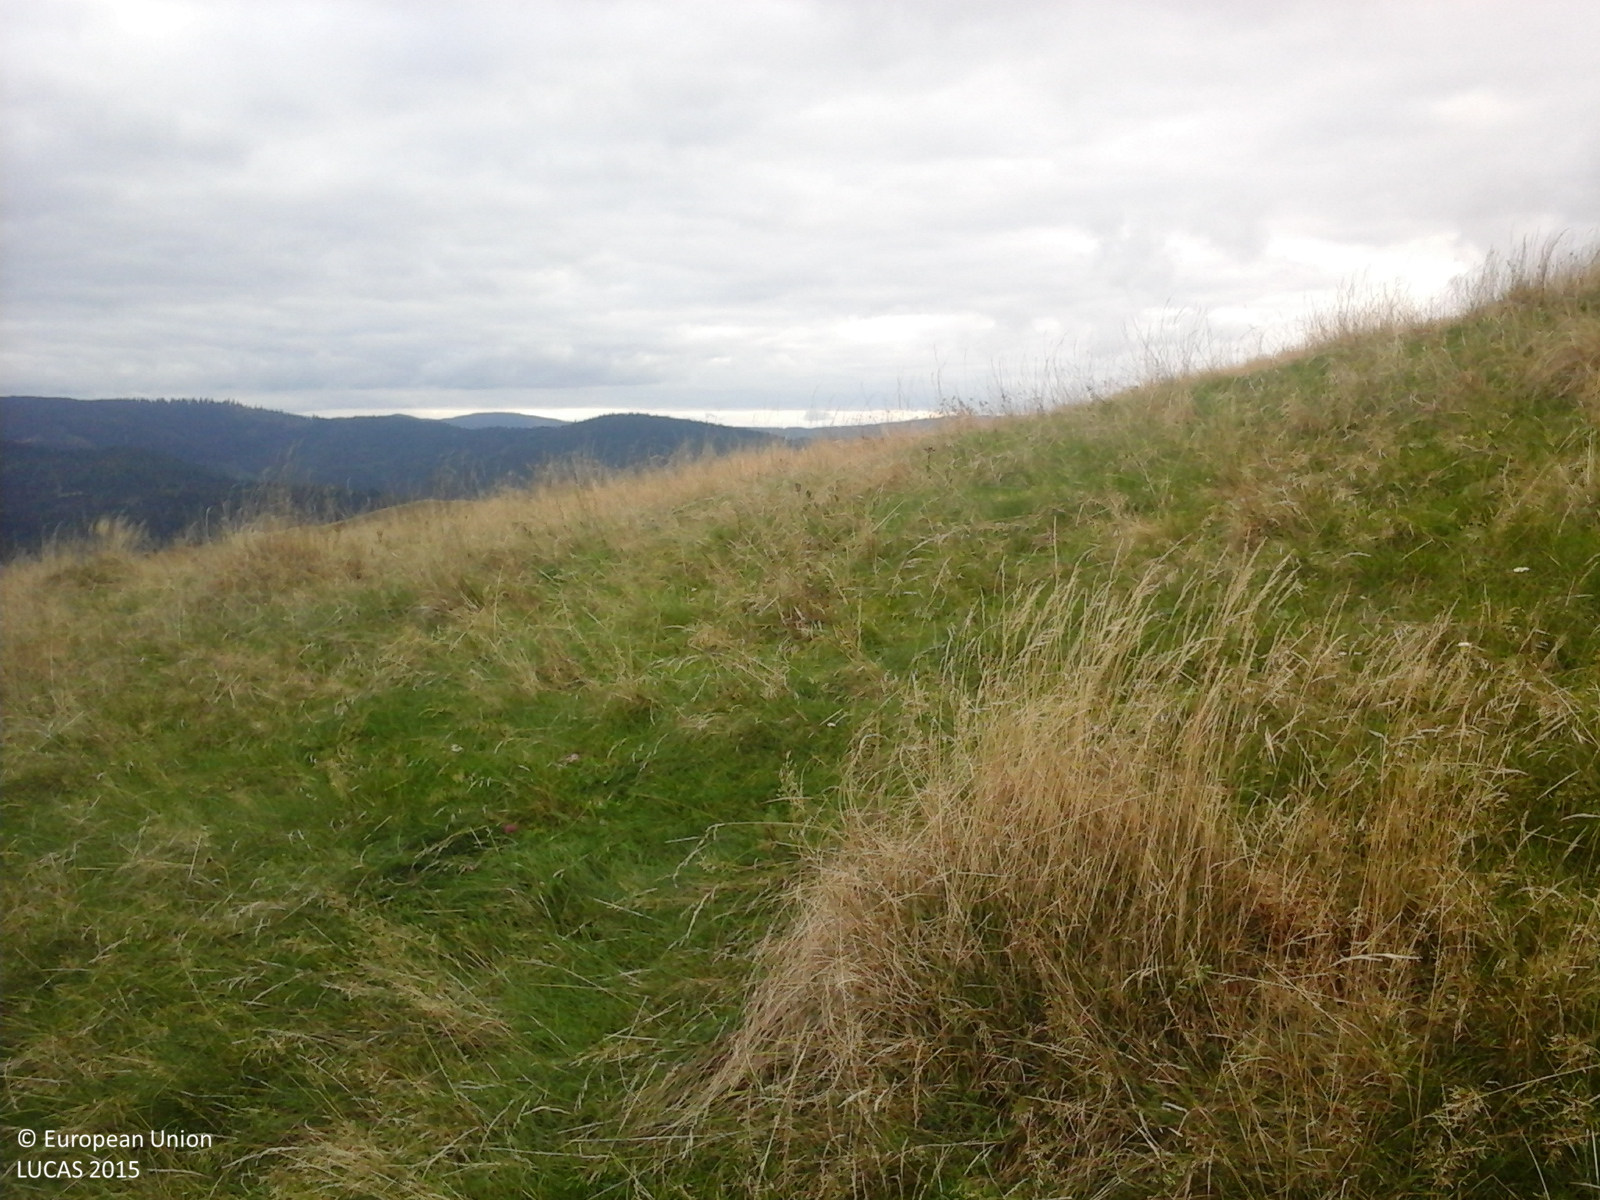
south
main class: Grassland
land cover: Spontaneously vegetated surfaces
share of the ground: > 75 %
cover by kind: herbaceous plants 100 %
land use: Agriculture (excluding fallow land and kitchen gardens)
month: September
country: RO
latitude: 46.7302
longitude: 22.9224
